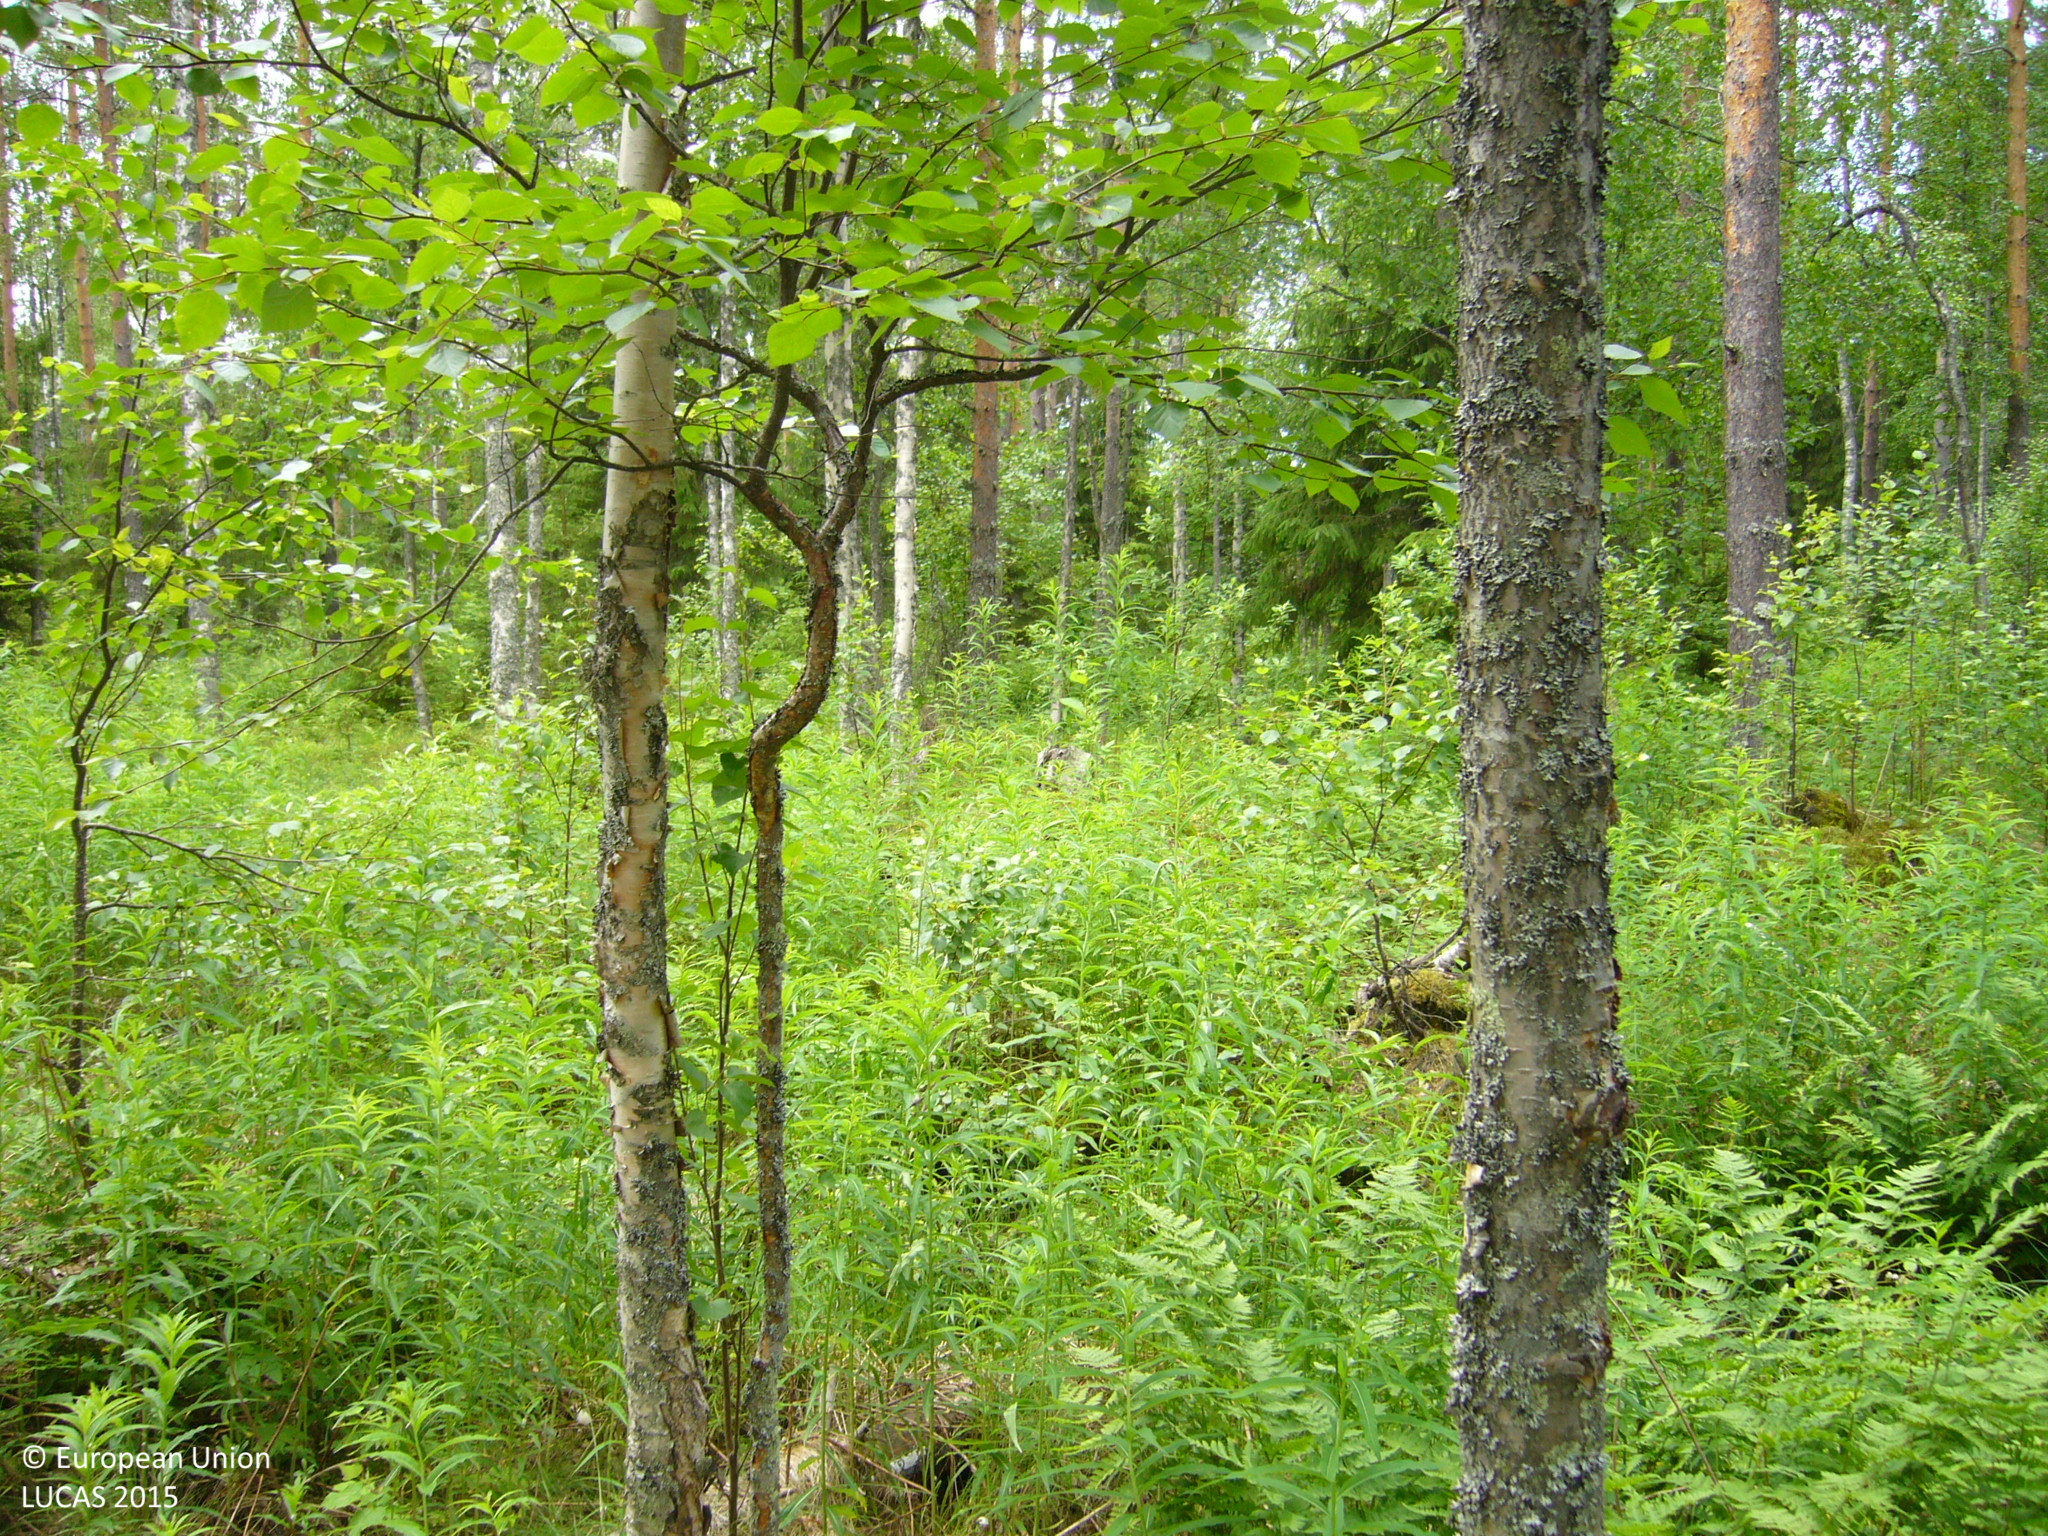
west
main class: Woodland
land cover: Pine dominated mixed woodland
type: boreal forest
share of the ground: 50 - 75 %
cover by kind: broadleaved forest trees 40 %, shrubs 35 %, coniferous forest trees 25 %
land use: Forestry
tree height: > 5 m
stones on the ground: 10 - 25 %
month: July
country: FI
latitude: 63.2345
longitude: 26.1015
